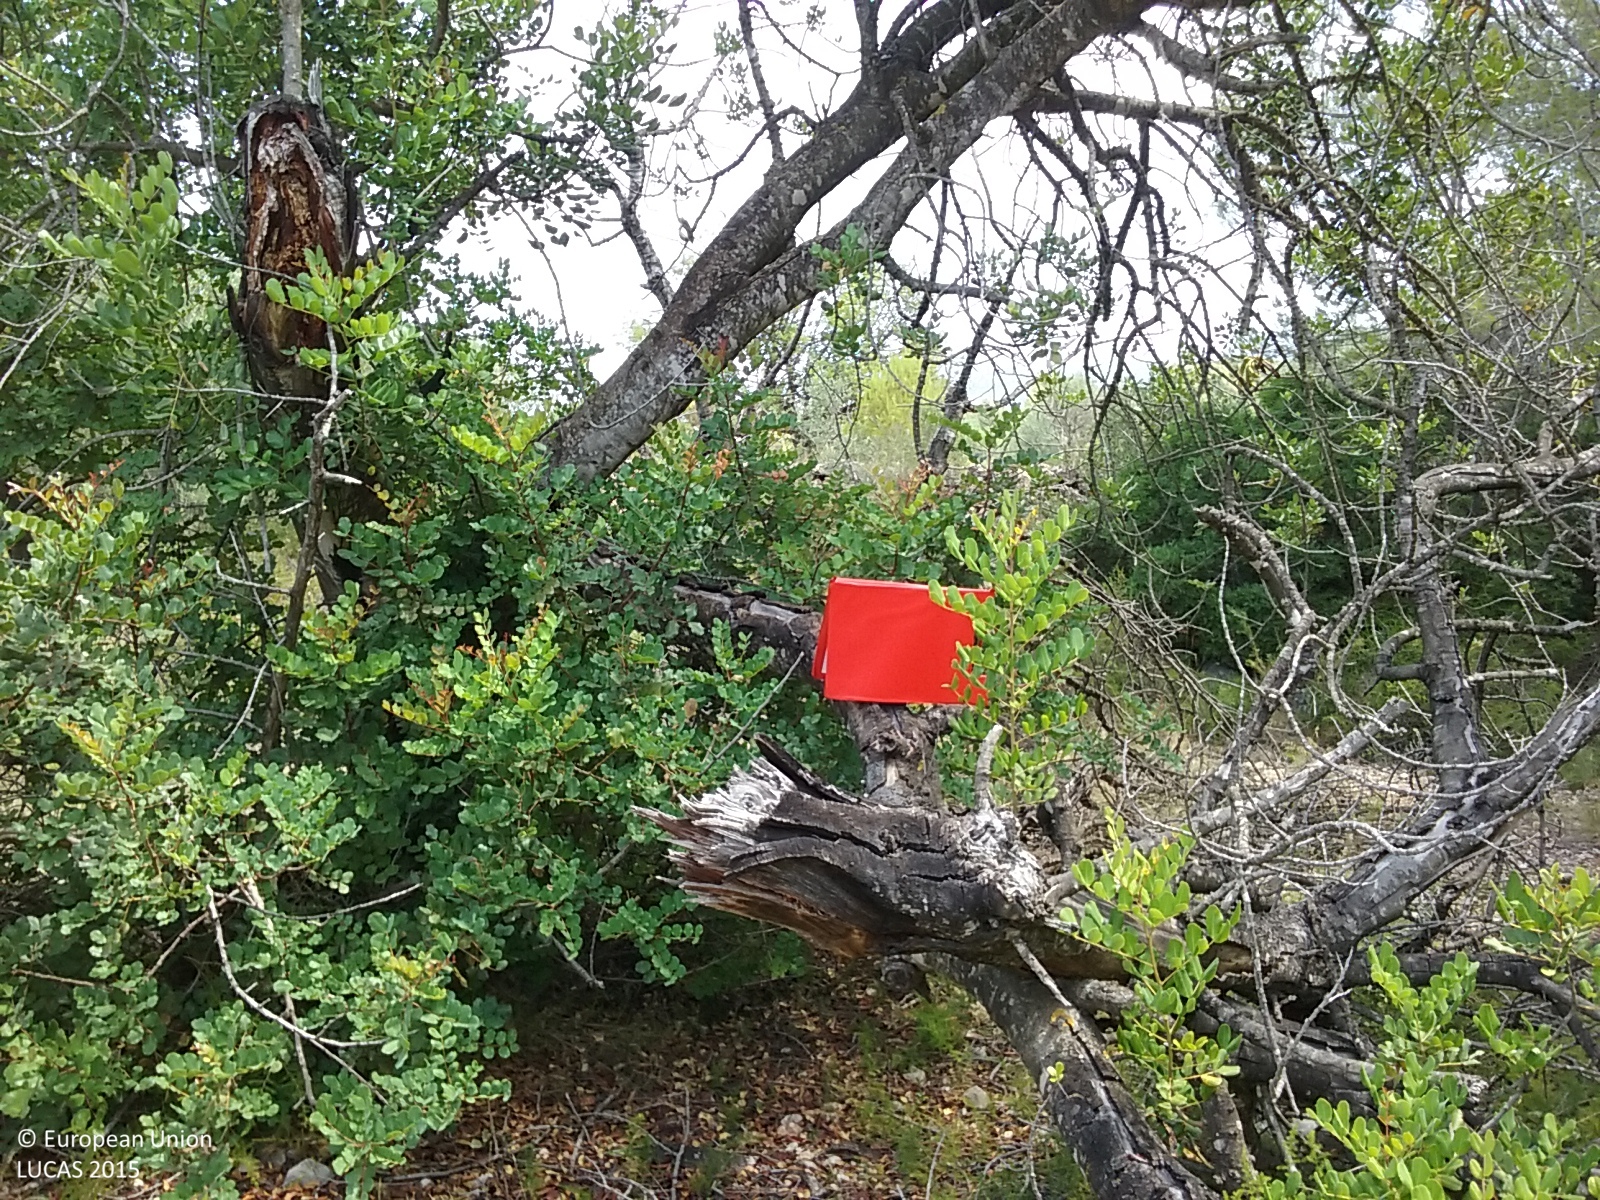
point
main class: Cropland
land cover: Permanent industrial crops
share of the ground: 10 - 25 %
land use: Abandoned areas
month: July
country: ES
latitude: 40.2570
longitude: -0.0799
